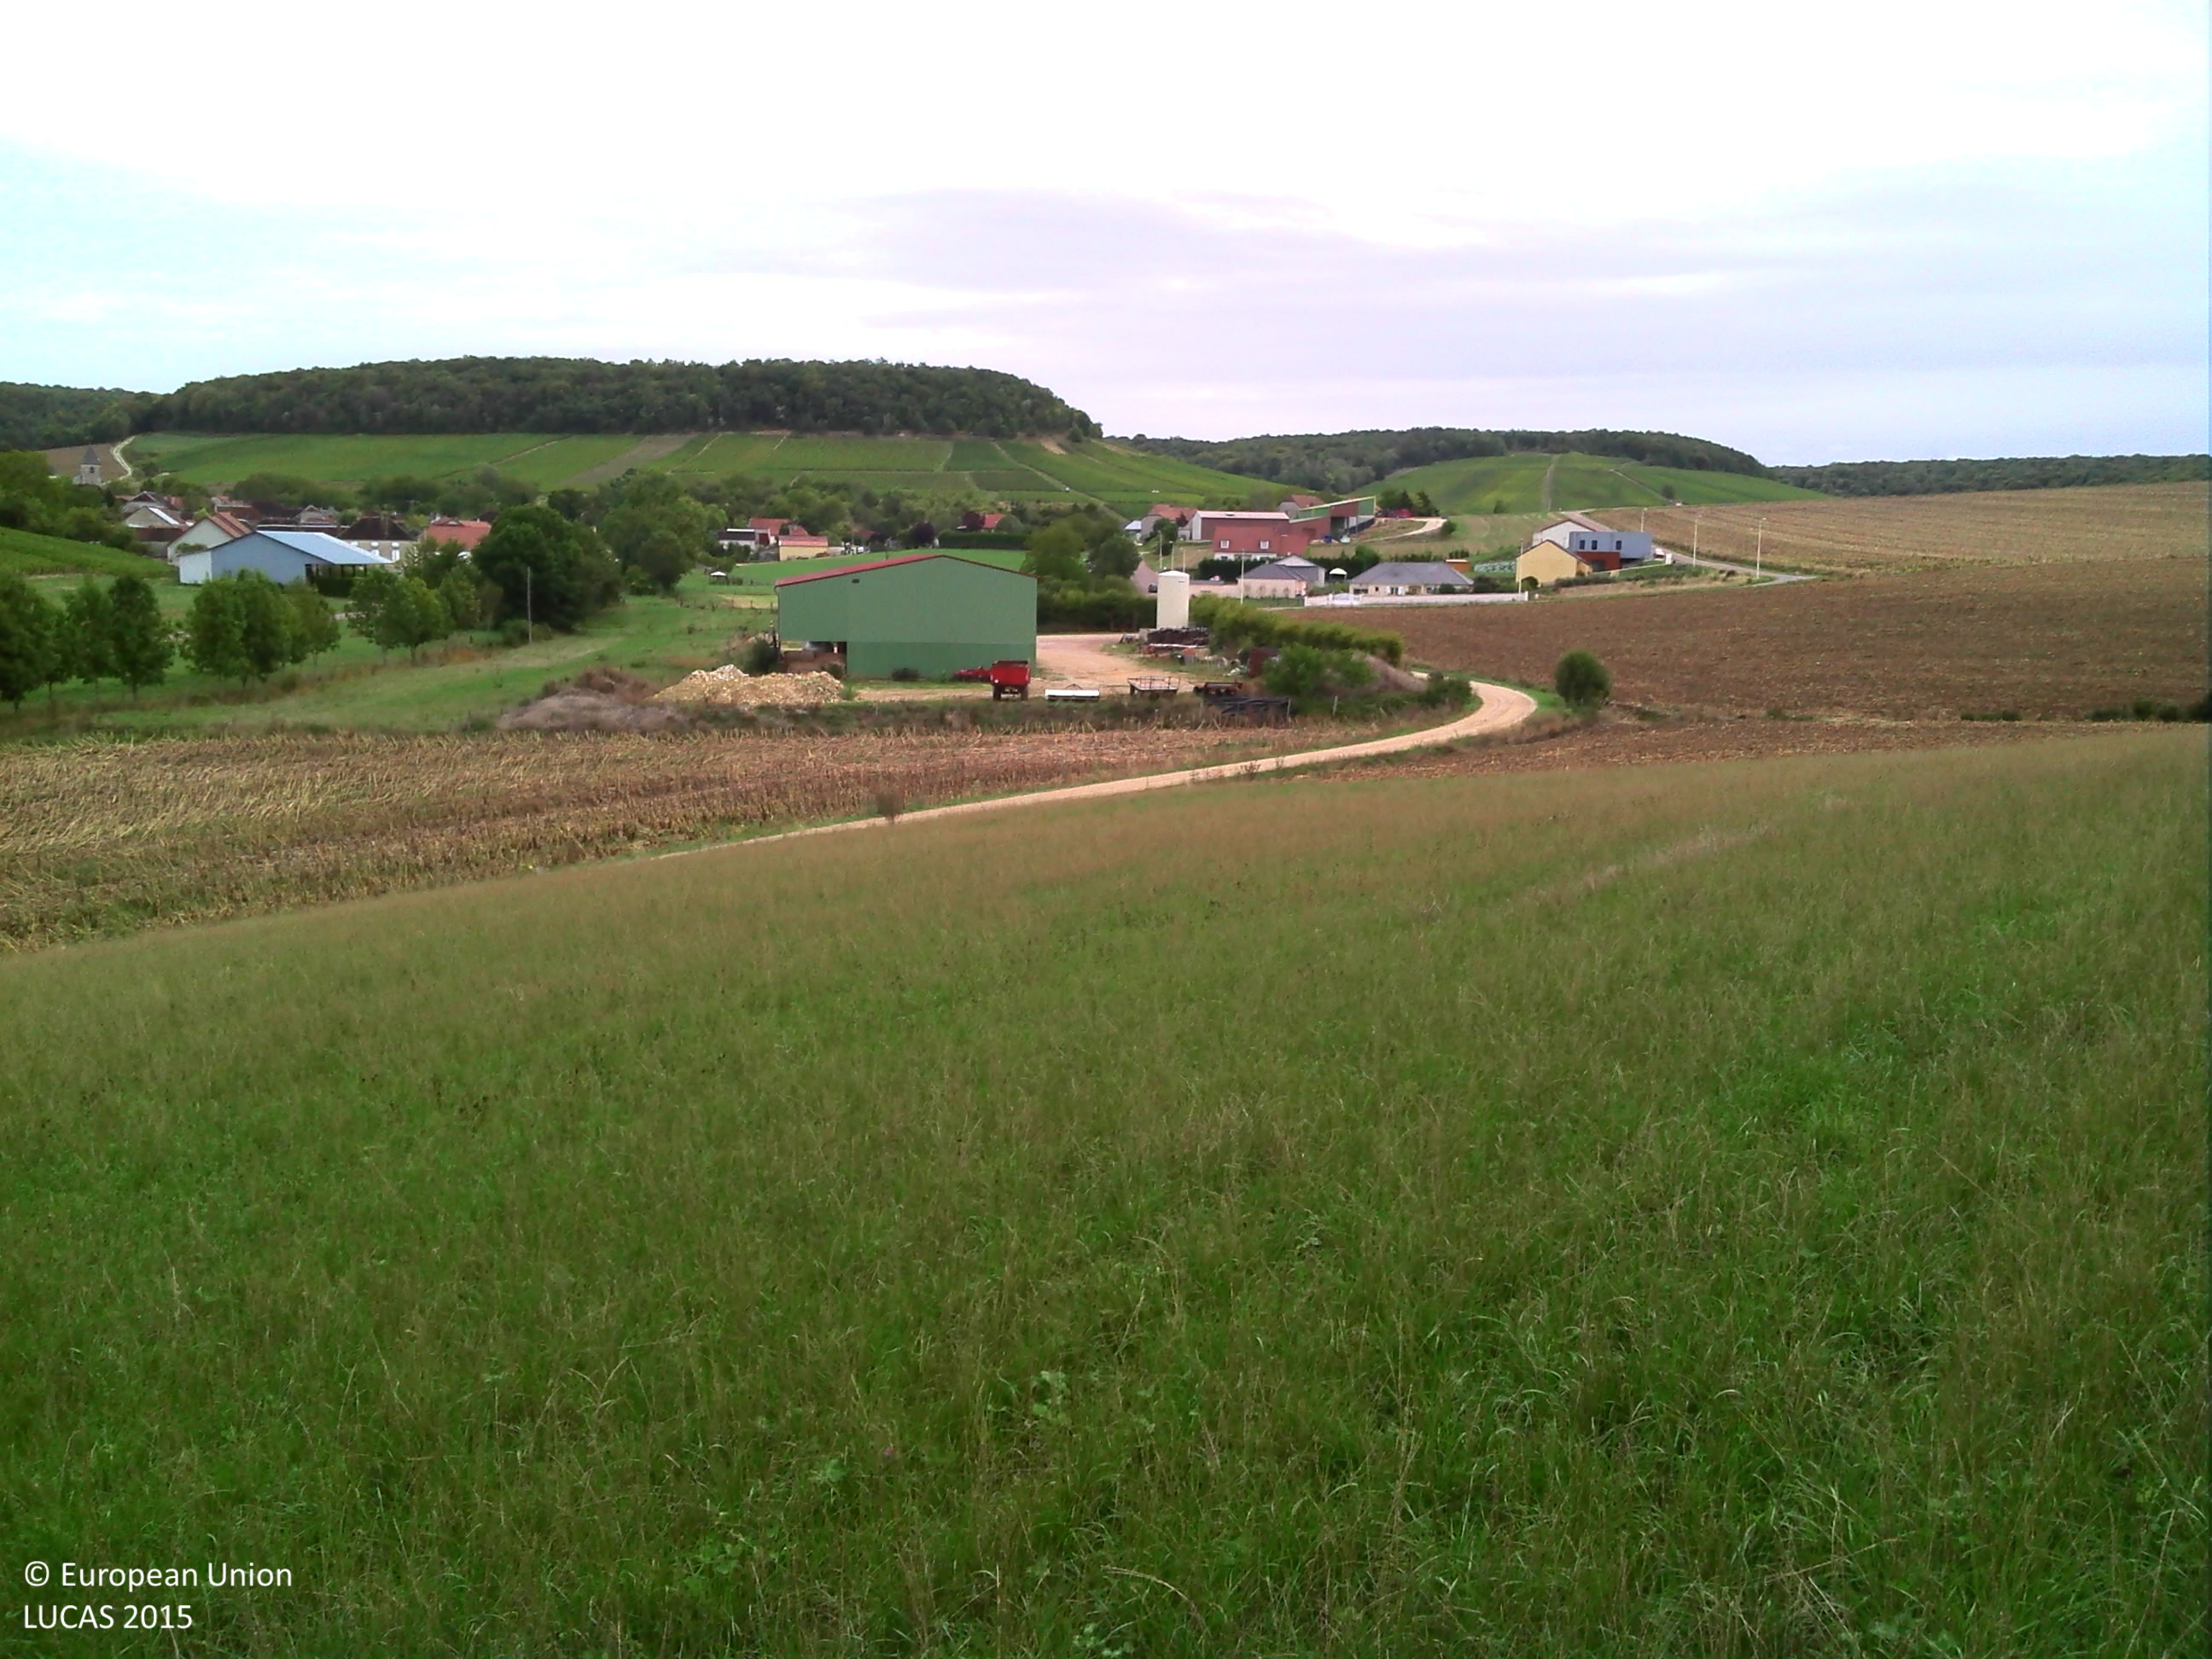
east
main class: Cropland
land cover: Temporary grasslands
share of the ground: > 75 %
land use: Agriculture (excluding fallow land and kitchen gardens)
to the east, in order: Temporary grasslands; Grass margins; Tracks; Grass margins; Sunflower; Ditches and canals; Artificial constructions in urban areas; Lucerne
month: September
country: FR
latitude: 48.1842
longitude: 4.6583
